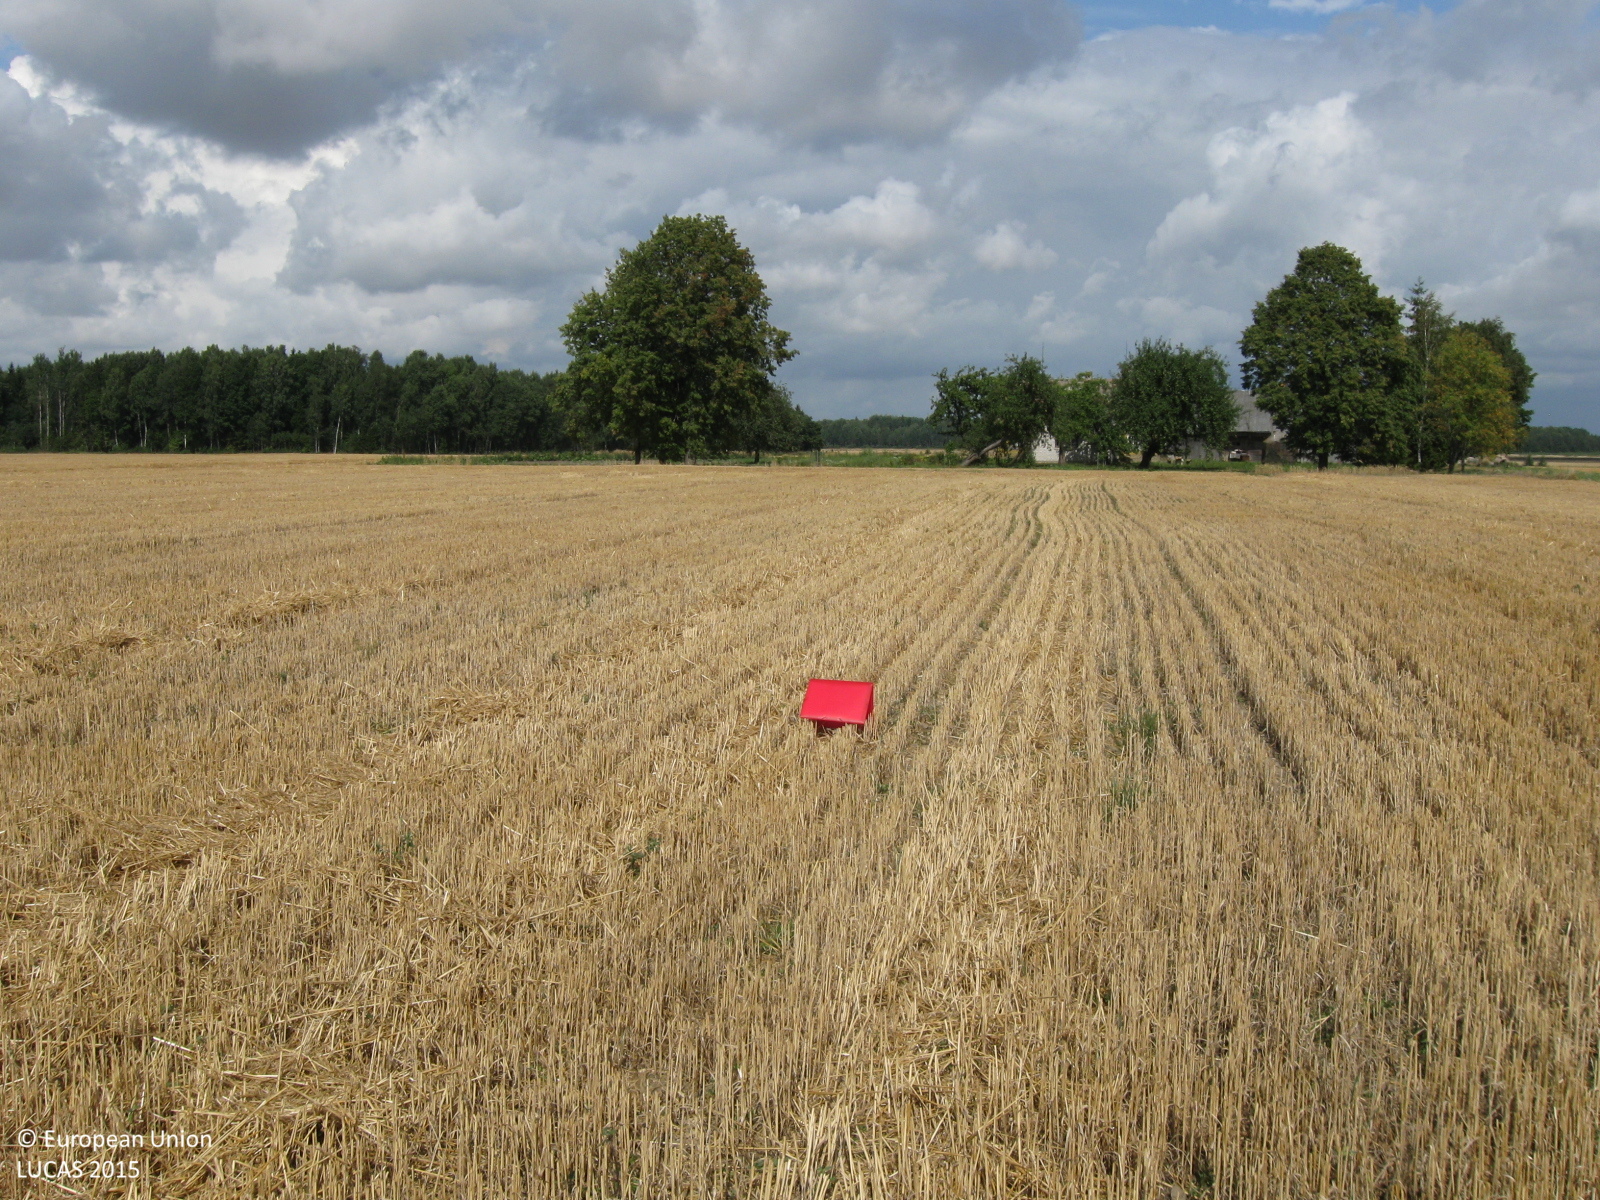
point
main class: Cropland
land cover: Common wheat
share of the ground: > 75 %
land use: Agriculture (excluding fallow land and kitchen gardens)
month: August
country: LT
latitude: 55.2521
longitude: 23.1464
